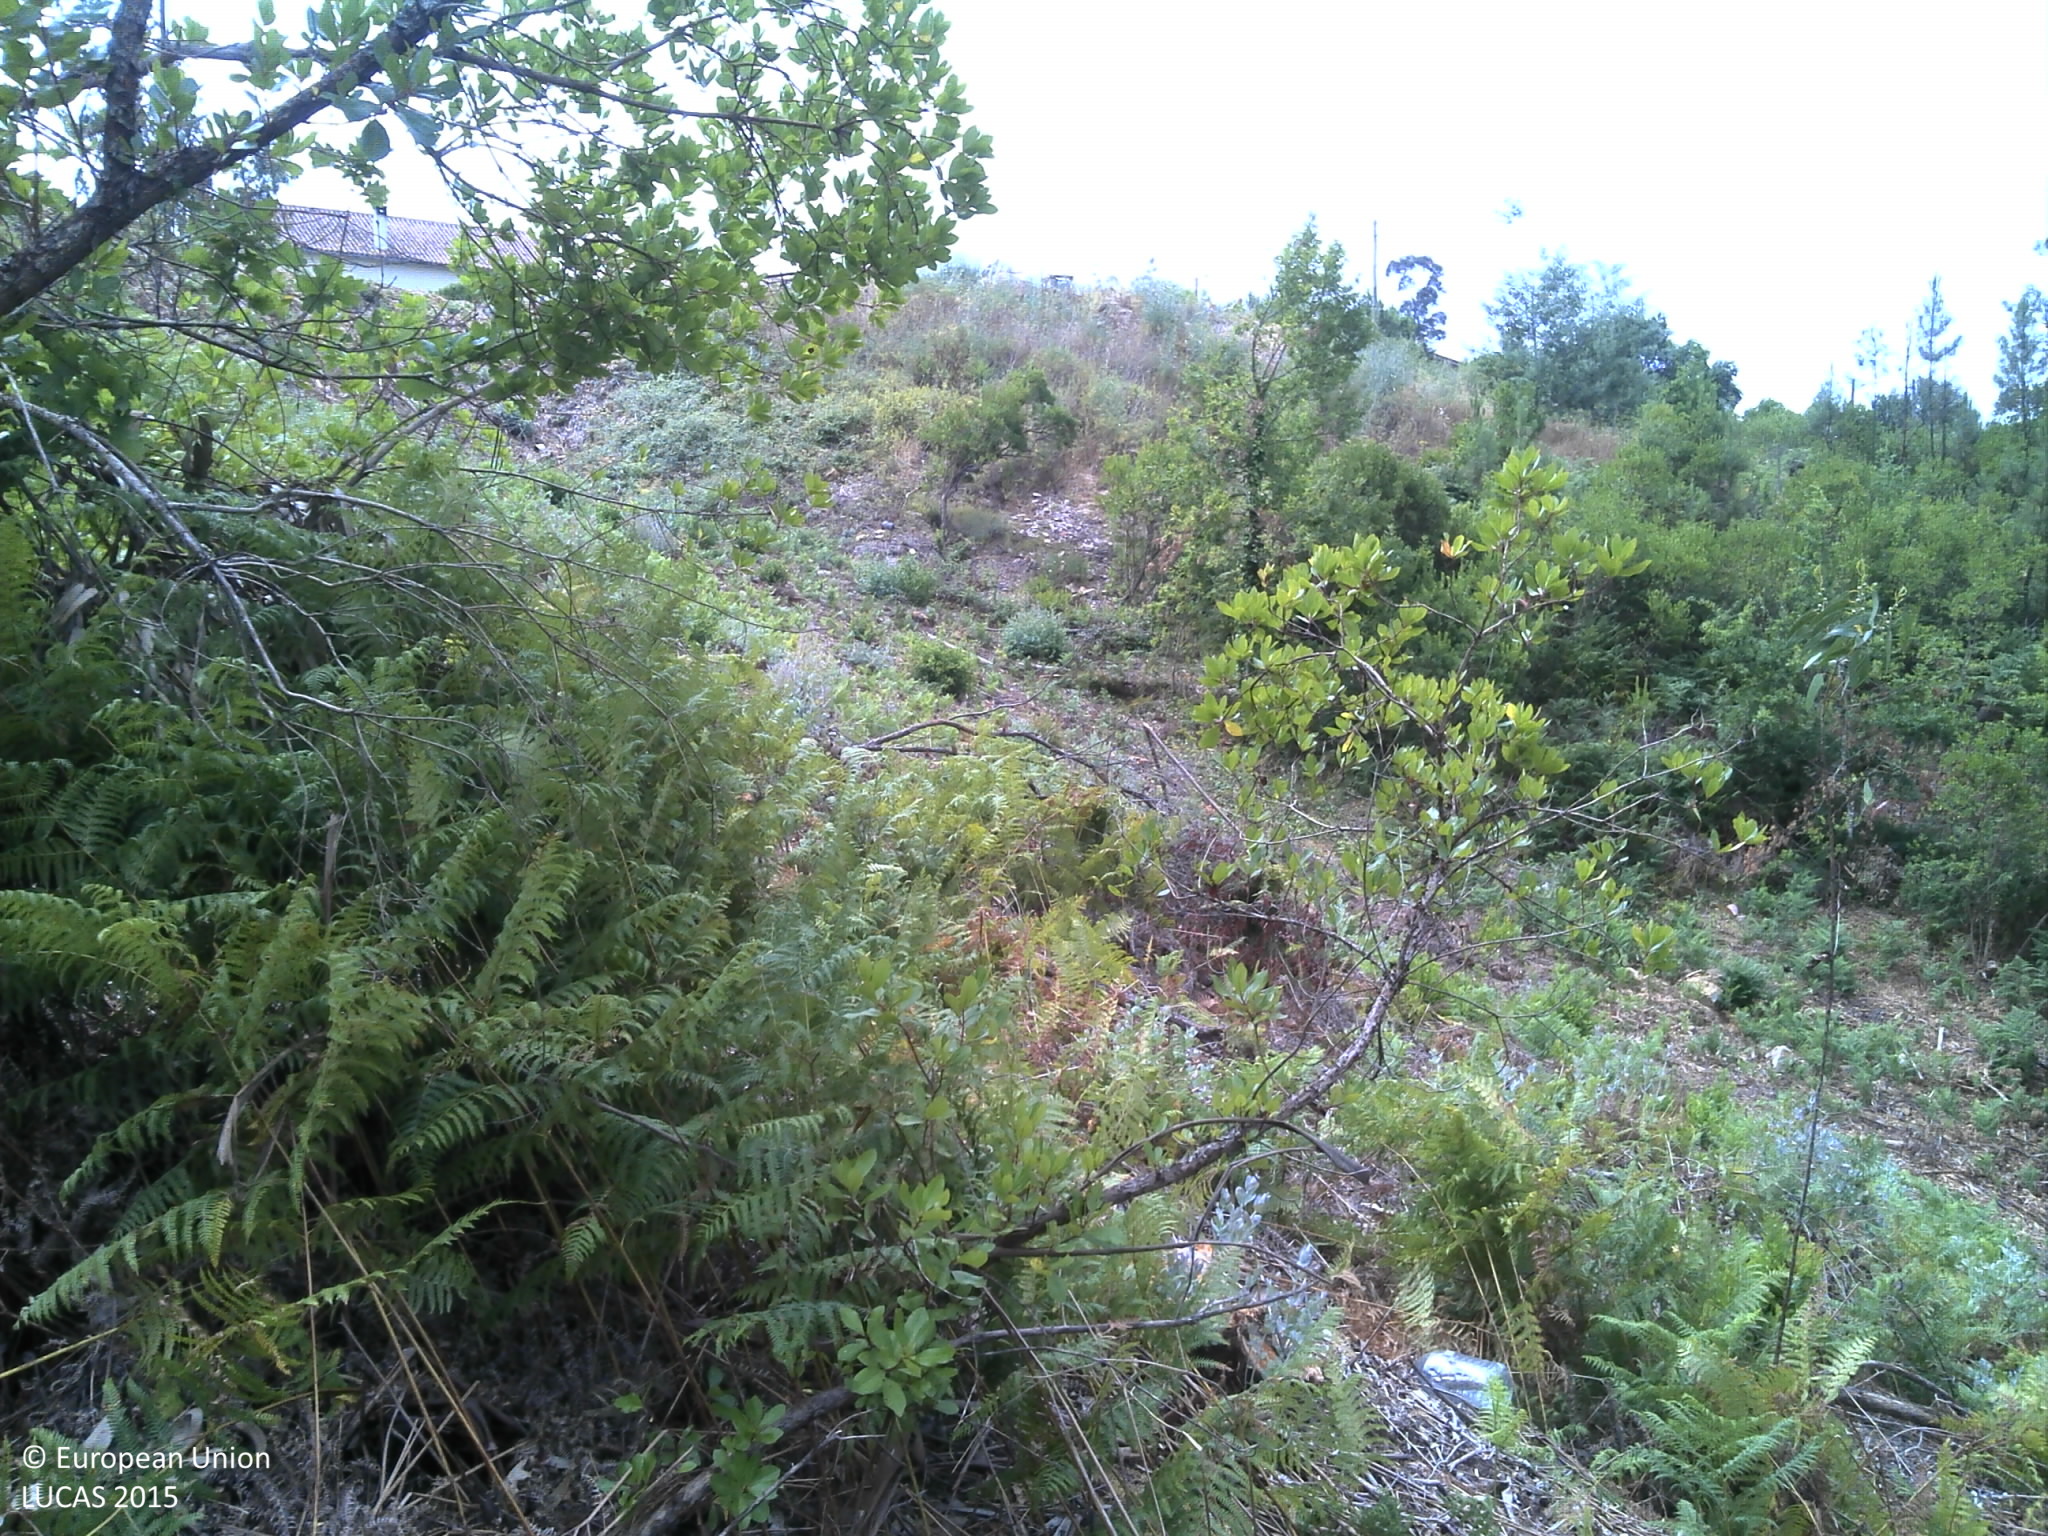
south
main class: Woodland
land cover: Broadleaved woodland
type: exotic forest
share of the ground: < 10 %
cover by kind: unconsolidated bare surface 65 %, shrubs 20 %, broadleaved forest trees 10 %, consolidated bare surface 5 %
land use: Forestry
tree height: > 5 m
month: July
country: PT
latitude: 40.2988
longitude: -8.2326
